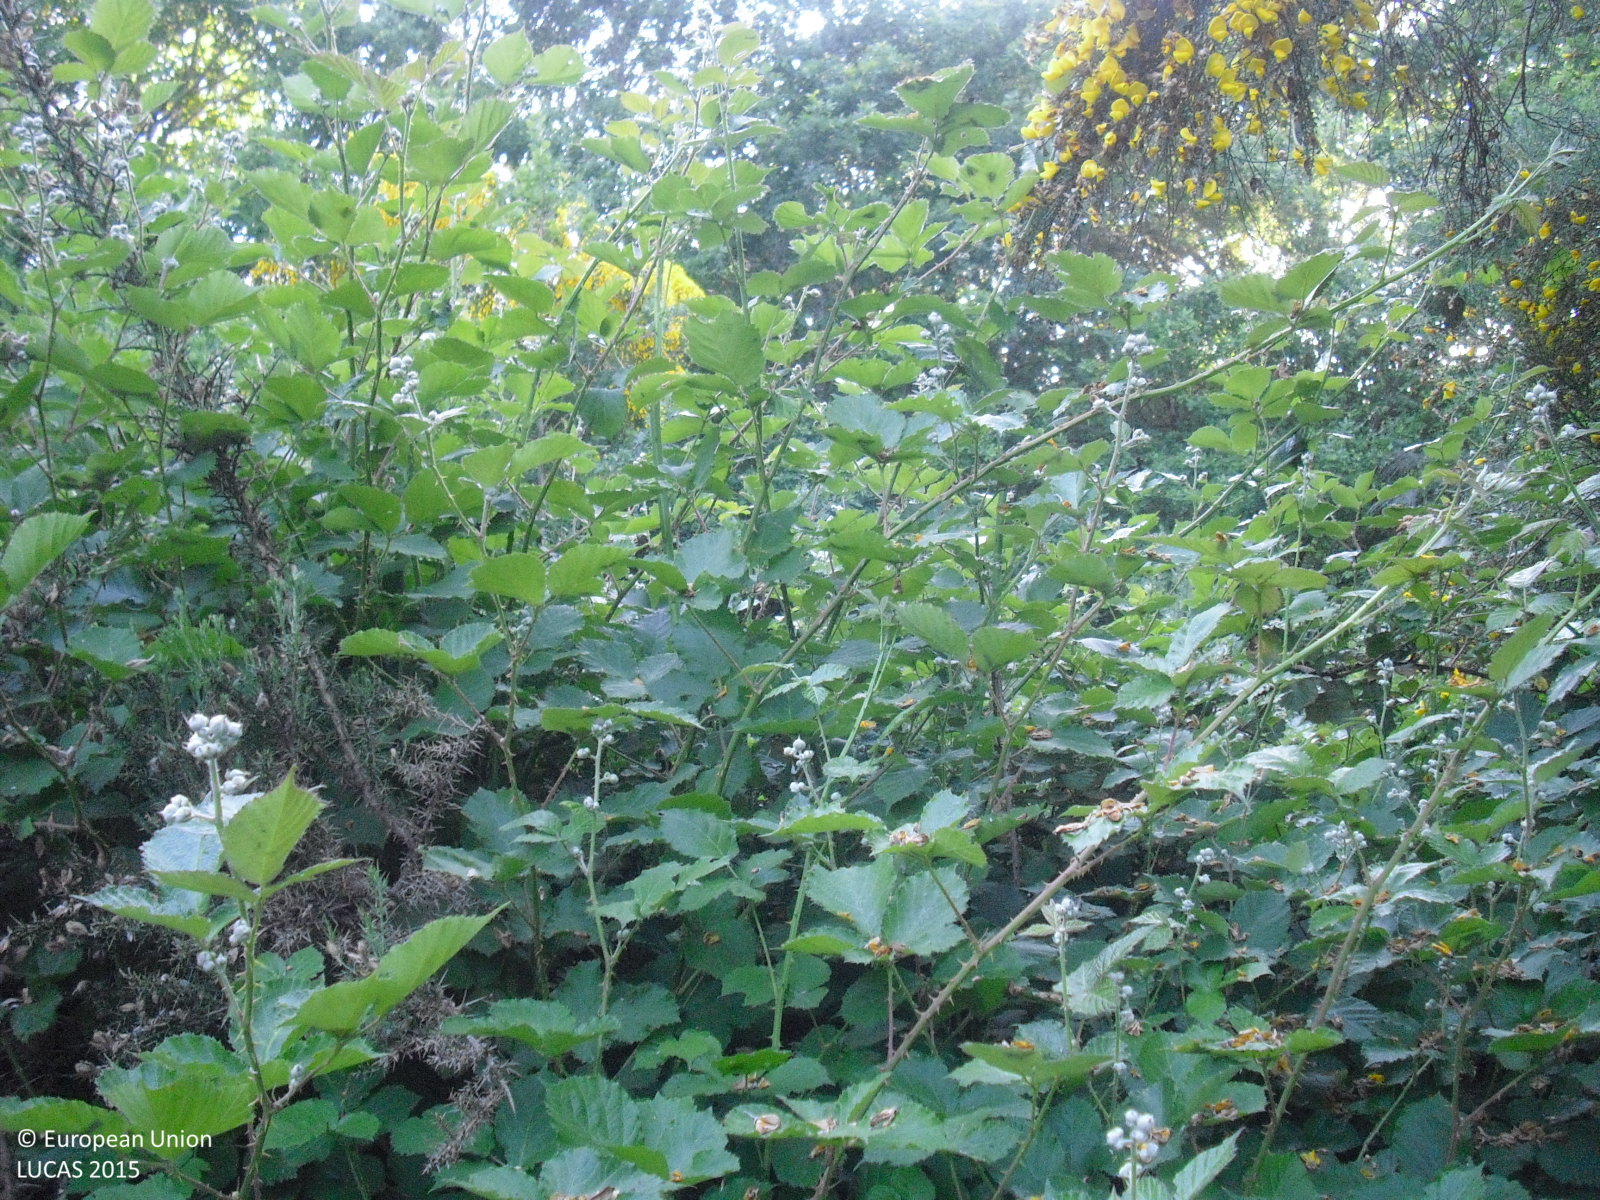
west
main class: Shrubland
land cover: Shrubland with sparse tree cover
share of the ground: > 75 %
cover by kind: shrubs 80 %, herbaceous plants 15 %, broadleaved forest trees 5 %
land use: Abandoned areas
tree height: < 5 m
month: May
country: ES
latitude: 42.2290
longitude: -7.7751
